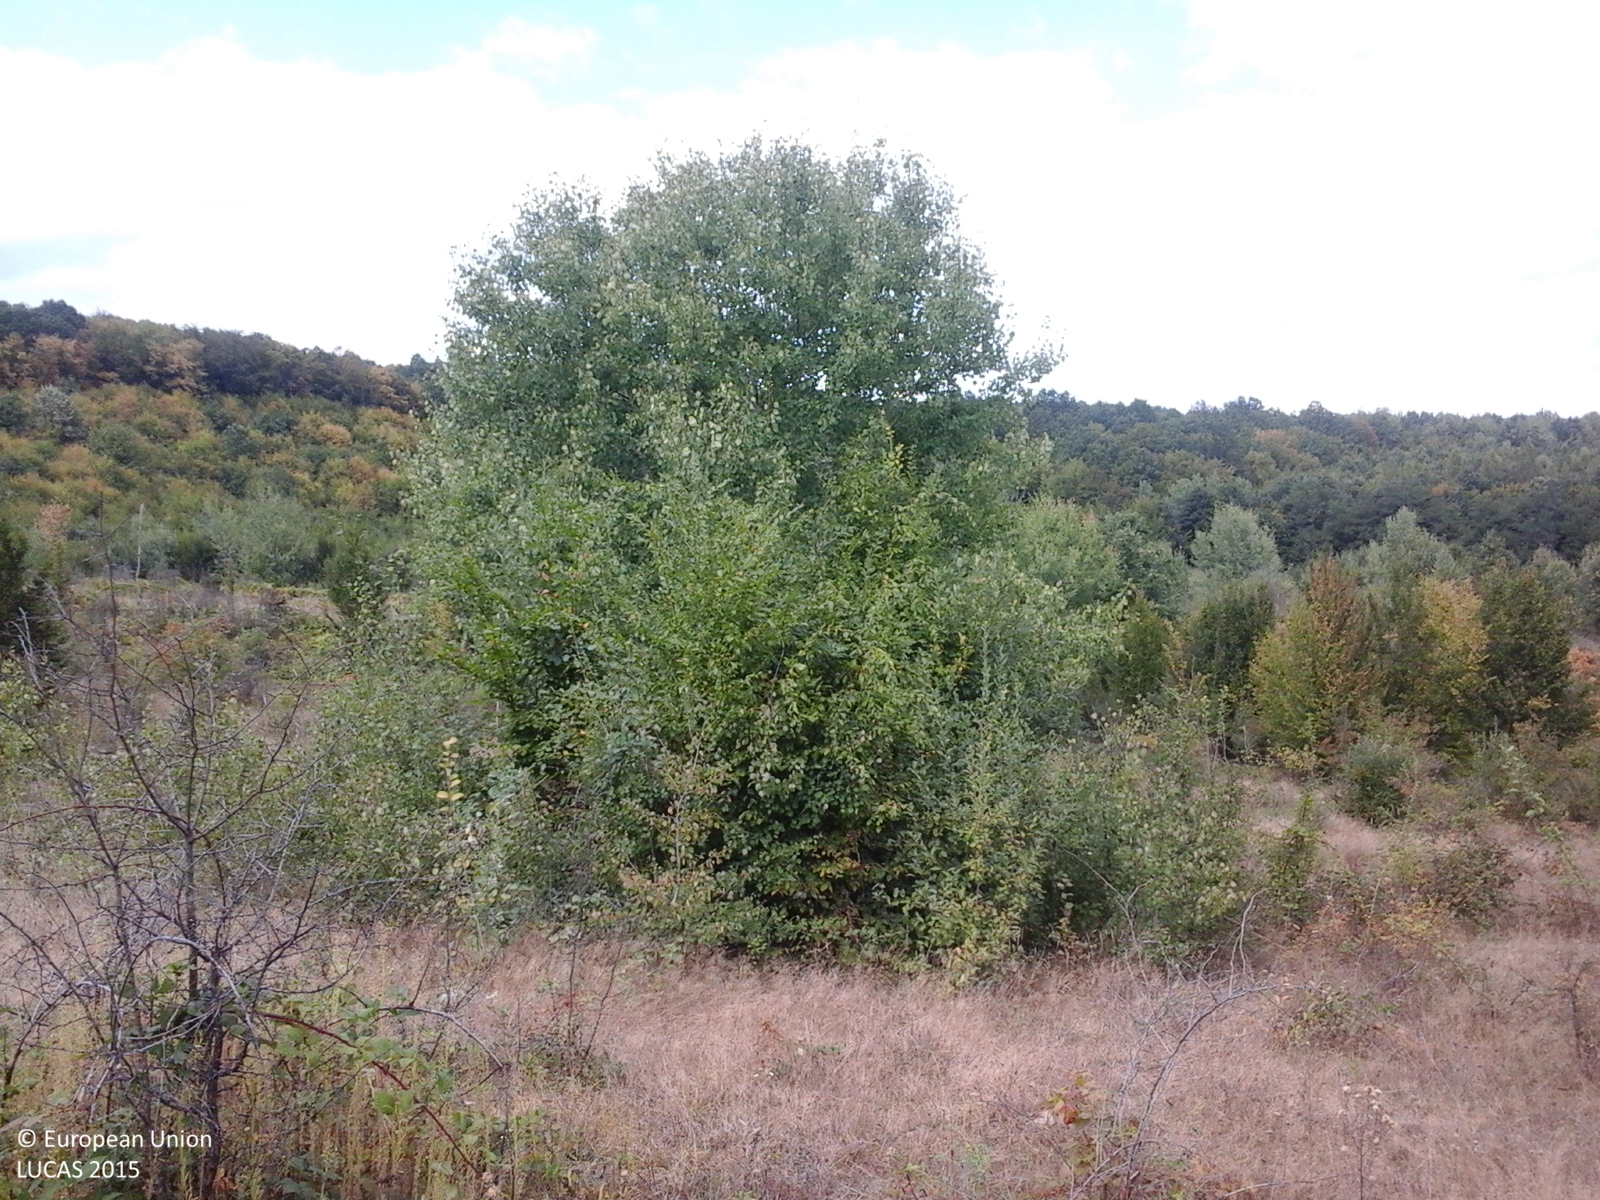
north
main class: Grassland
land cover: Grassland with sparse tree/shrub cover
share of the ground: > 75 %
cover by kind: herbaceous plants 85 %, shrubs 10 %, broadleaved forest trees 5 %
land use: Agriculture (excluding fallow land and kitchen gardens)
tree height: > 5 m
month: September
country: RO
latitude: 47.3284
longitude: 23.3958
